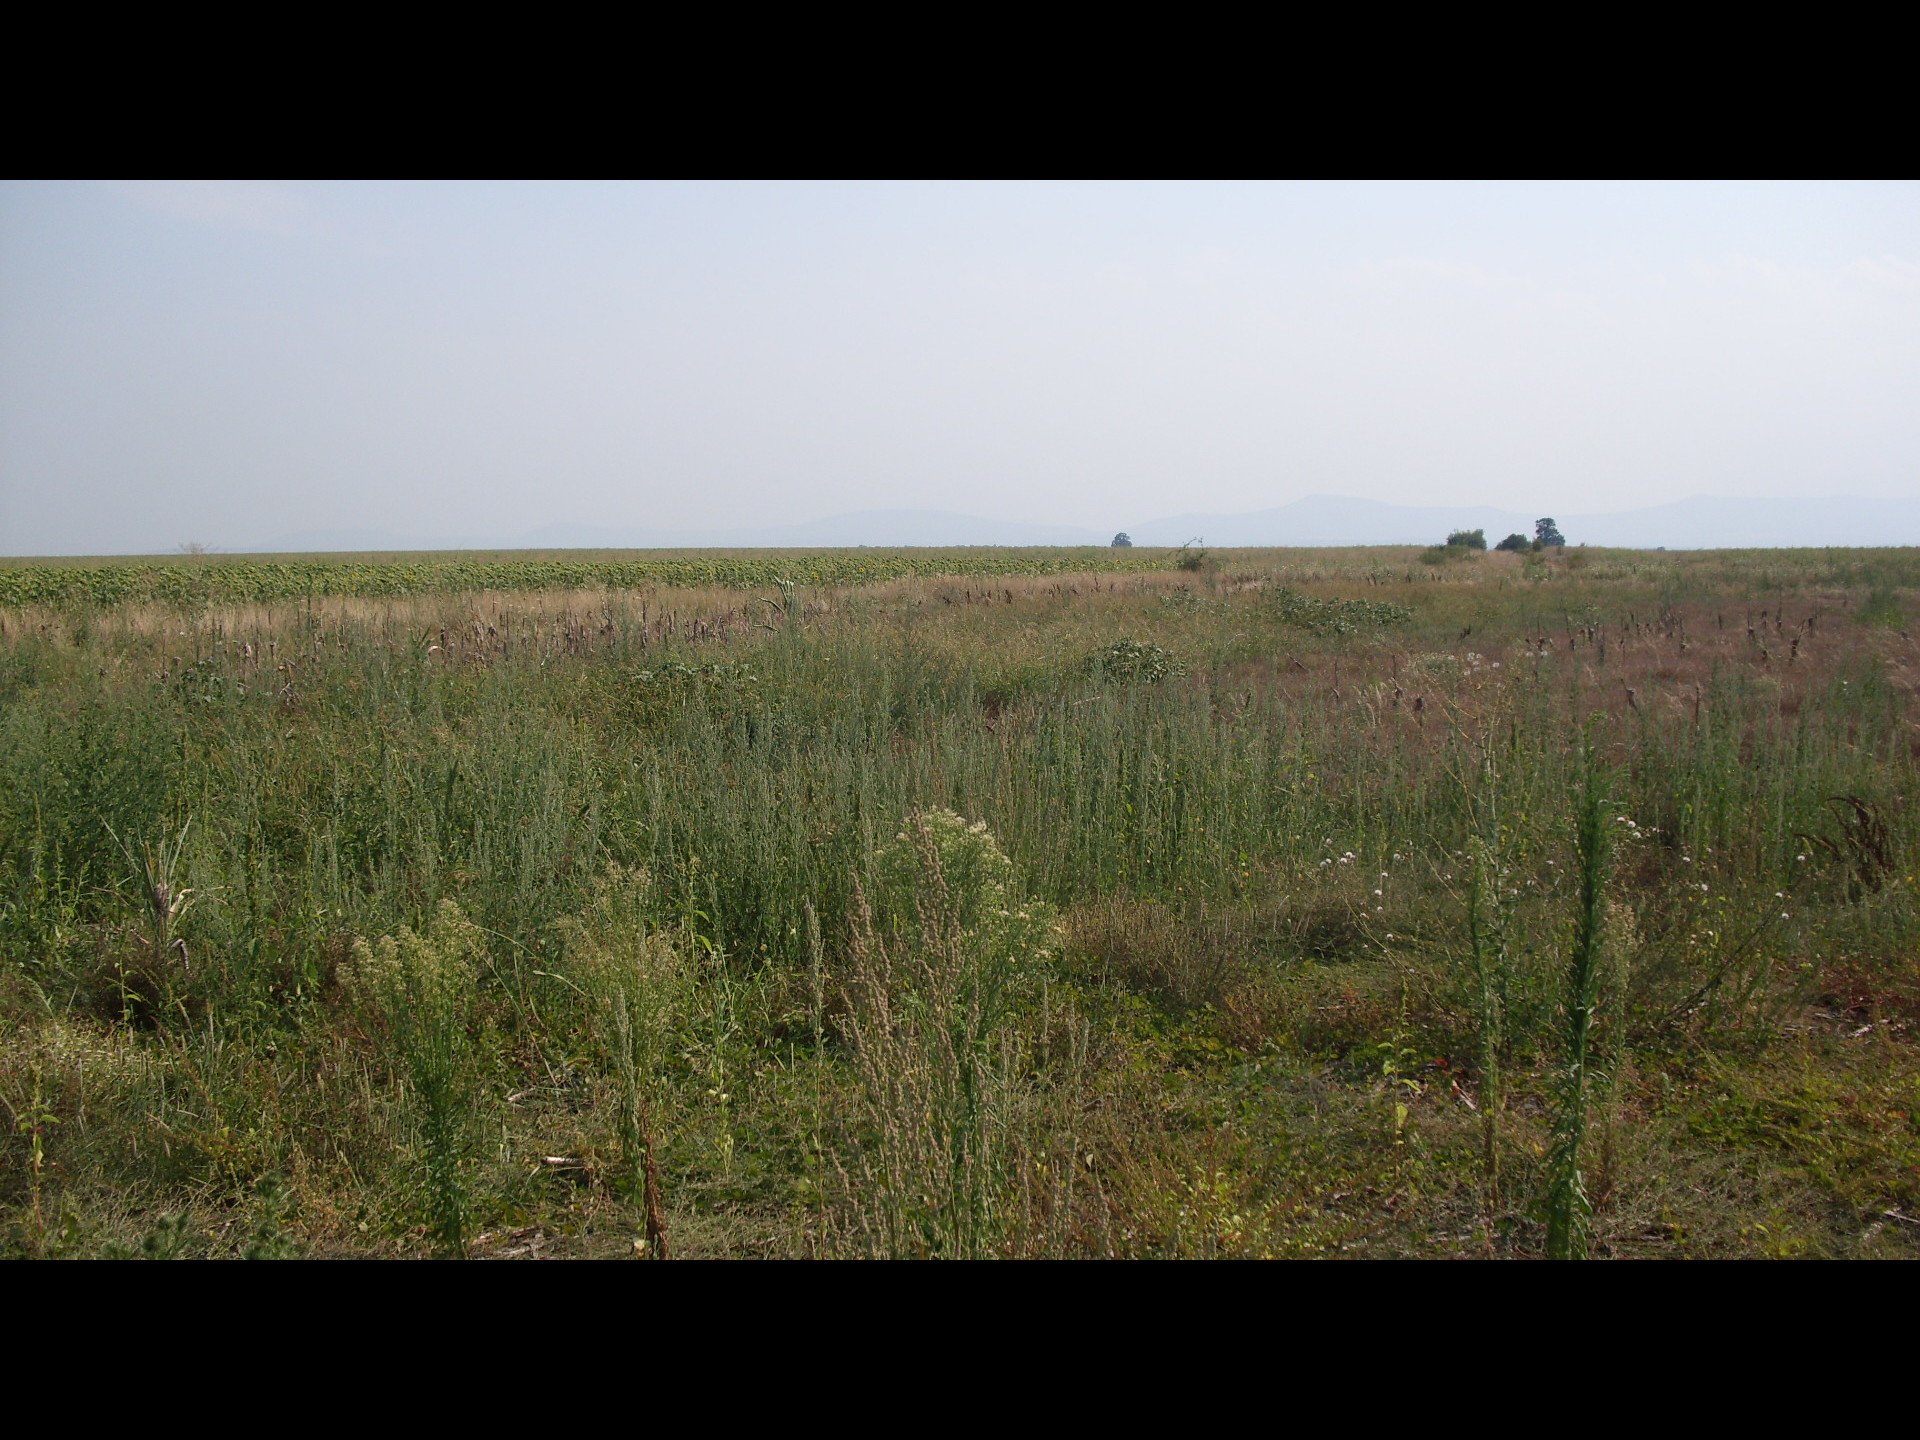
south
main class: Grassland
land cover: Spontaneously vegetated surfaces
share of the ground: > 75 %
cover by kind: herbaceous plants 100 %
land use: Fallow land
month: July
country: BG
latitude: 43.6269
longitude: 23.0899
